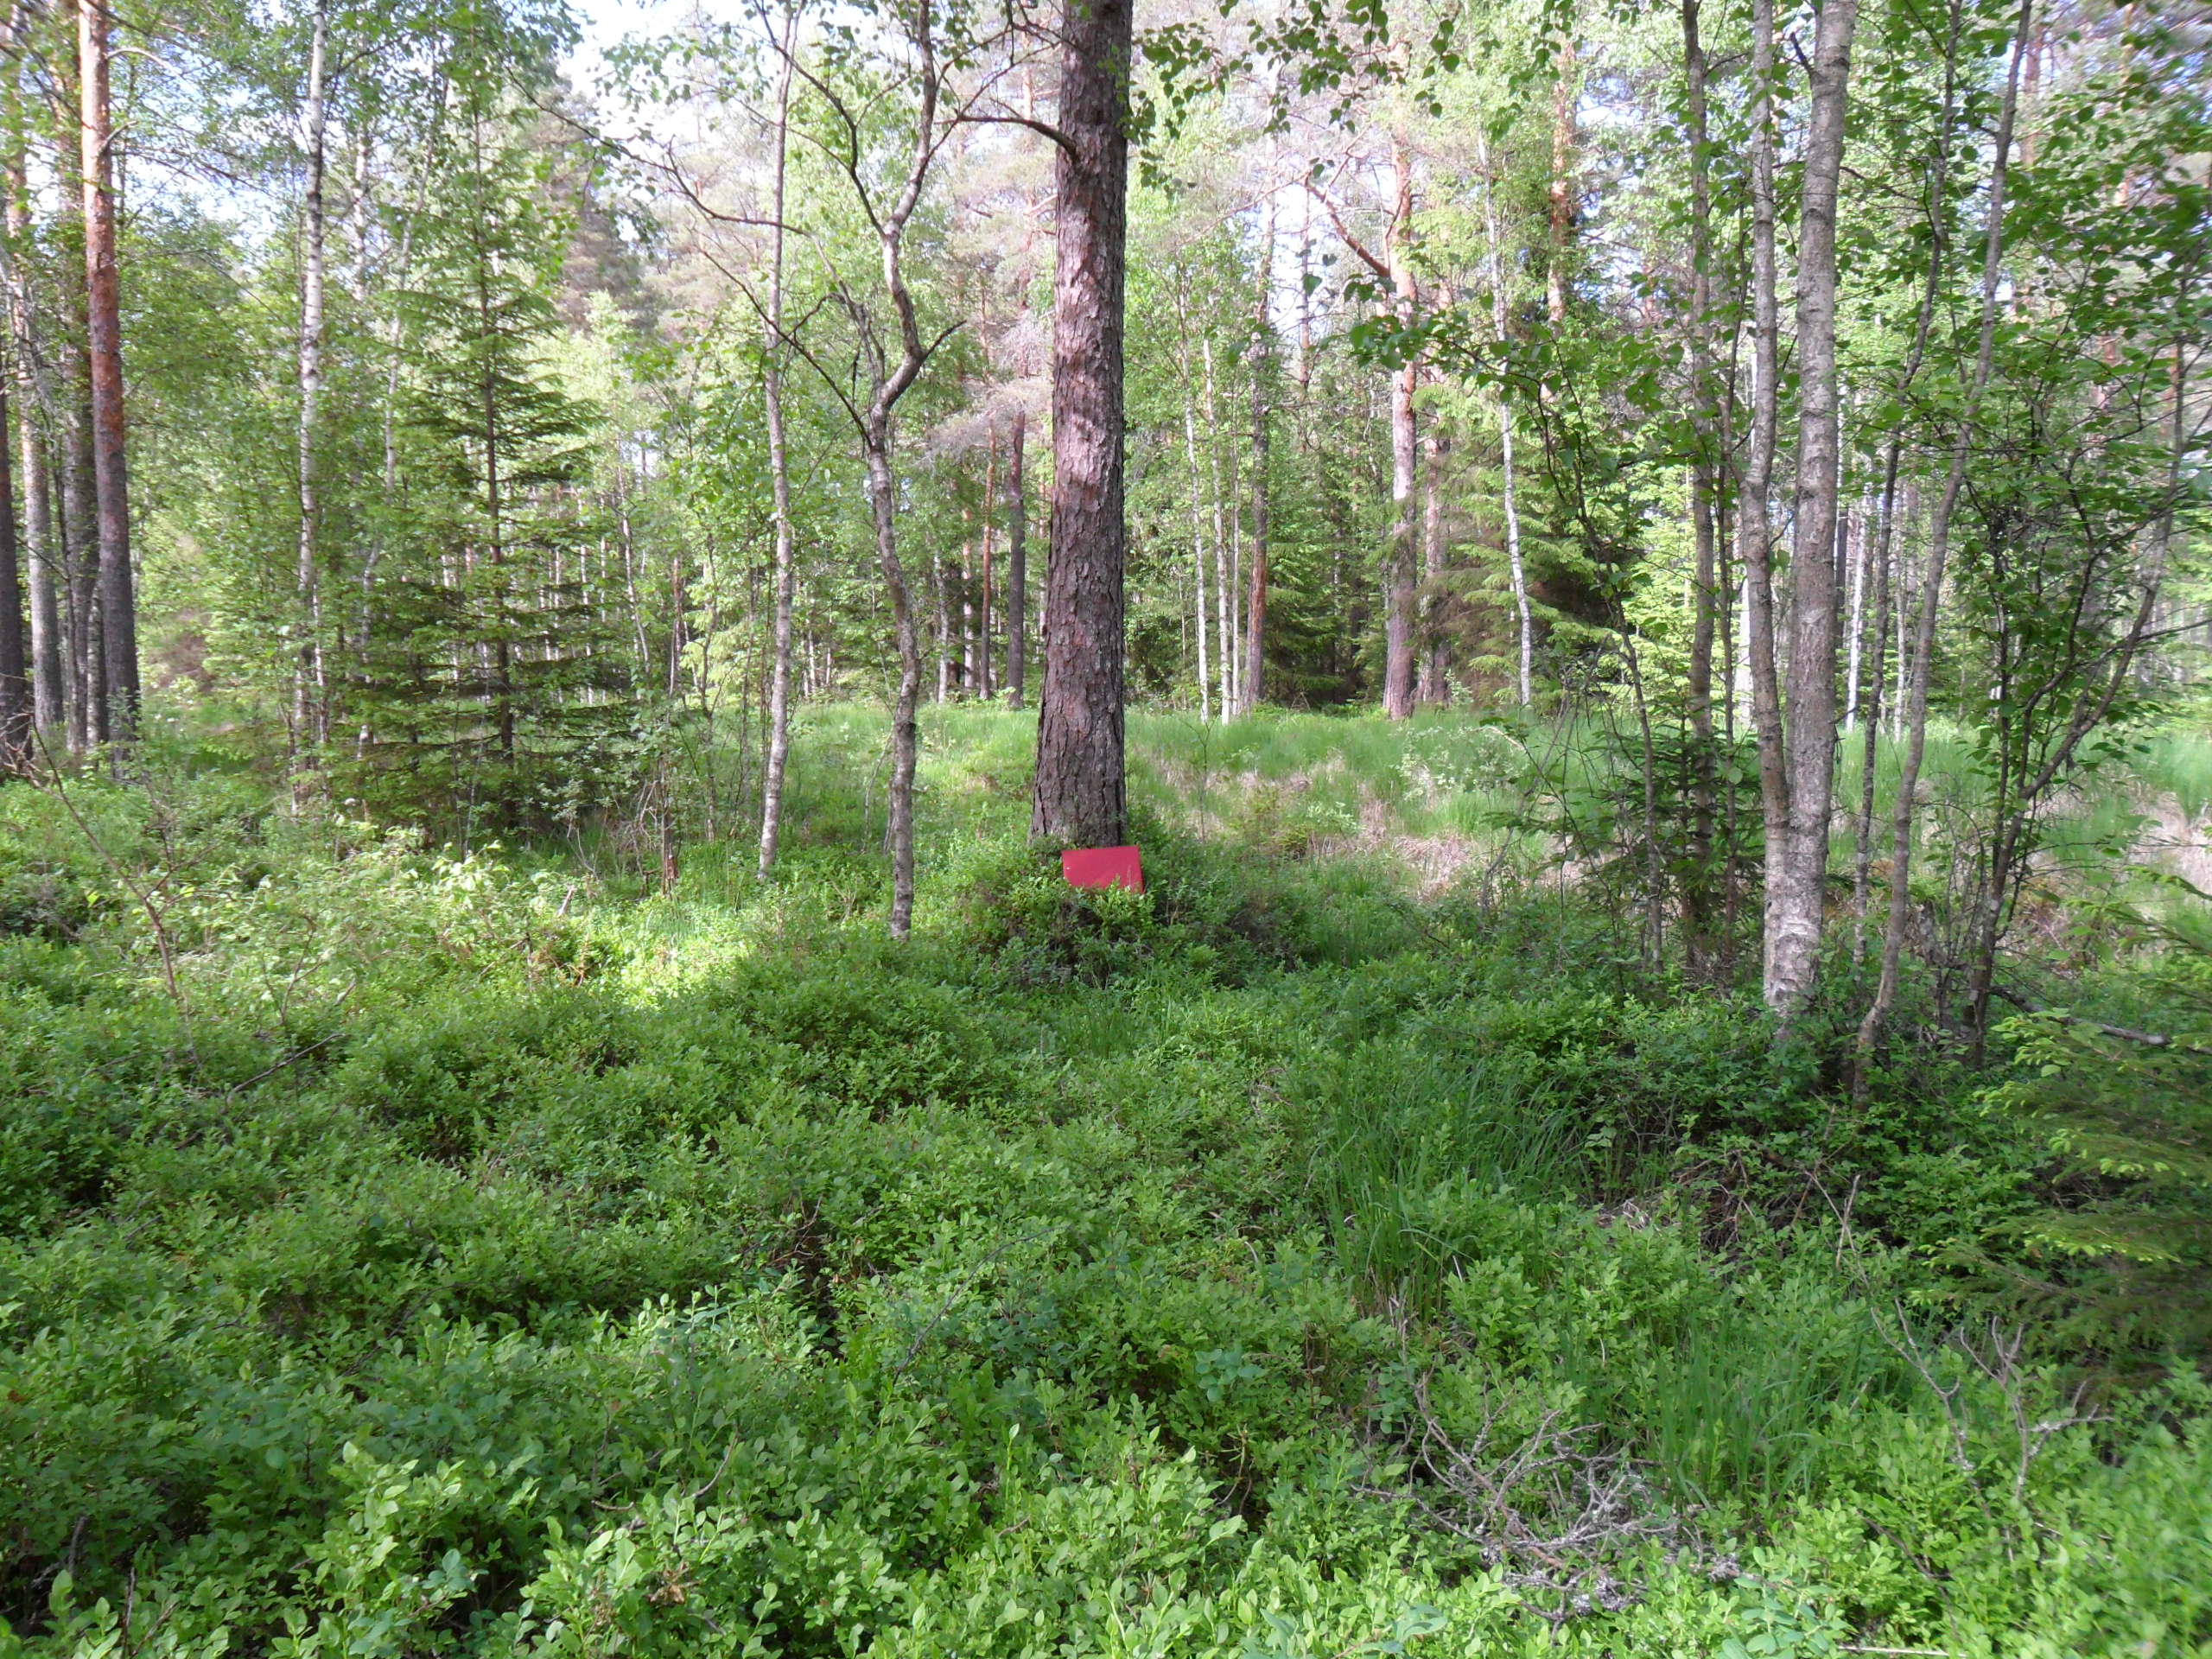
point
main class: Woodland
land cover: Pine dominated mixed woodland
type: hemiboreal forest and nemoral coniferous forest and mixed broadleaved-coniferous forest
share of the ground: 50 - 75 %
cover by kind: coniferous forest trees 45 %, broadleaved forest trees 25 %, herbaceous plants 15 %, lichens and mosses 10 %, shrubs 5 %
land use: Forestry
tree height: > 5 m
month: June
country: LV
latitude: 57.5918
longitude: 22.5498
